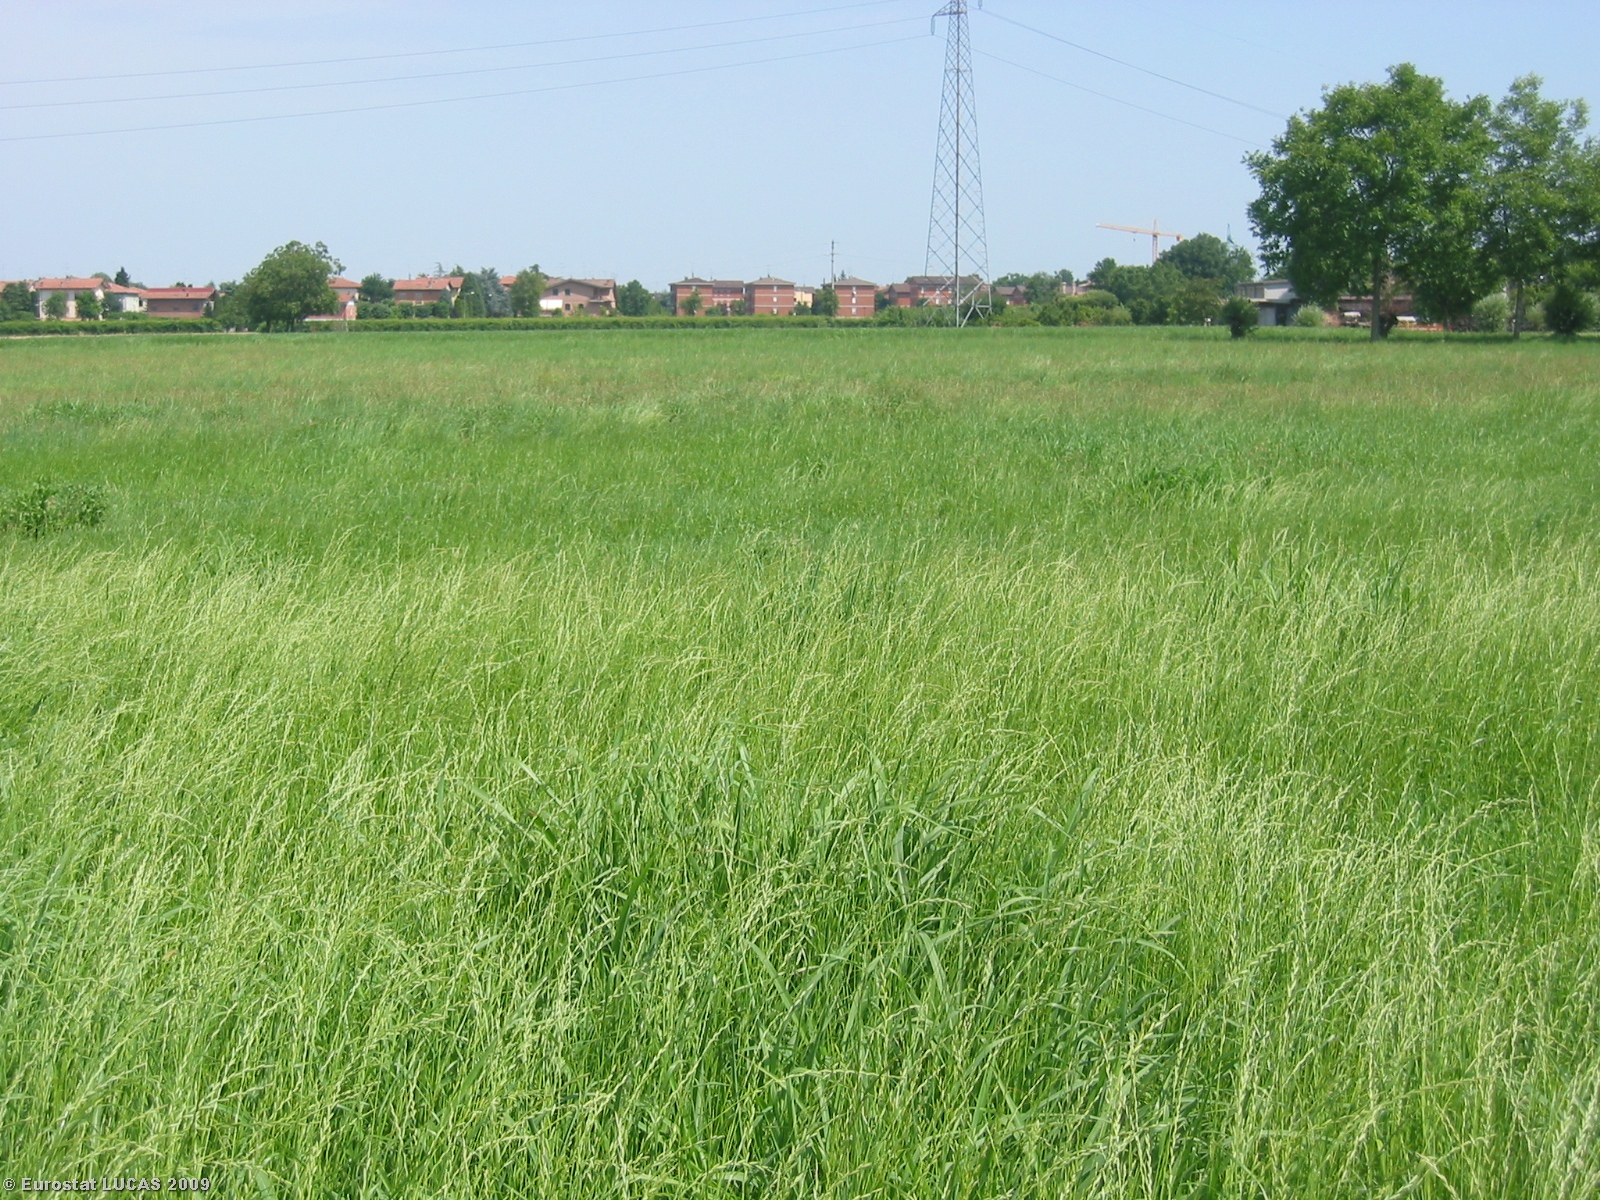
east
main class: Grassland
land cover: Grassland without tree/shrub cover
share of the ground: > 75 %
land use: Agriculture (excluding fallow land and kitchen gardens)
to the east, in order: Grassland without tree/shrub cover; Ditches and canals; Lucerne; Tracks; Electric lines; Lucerne; Grass margins; Tracks; Grass margins; Ditches and canals; Common wheat
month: June
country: IT
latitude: 44.5818
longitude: 10.8169
